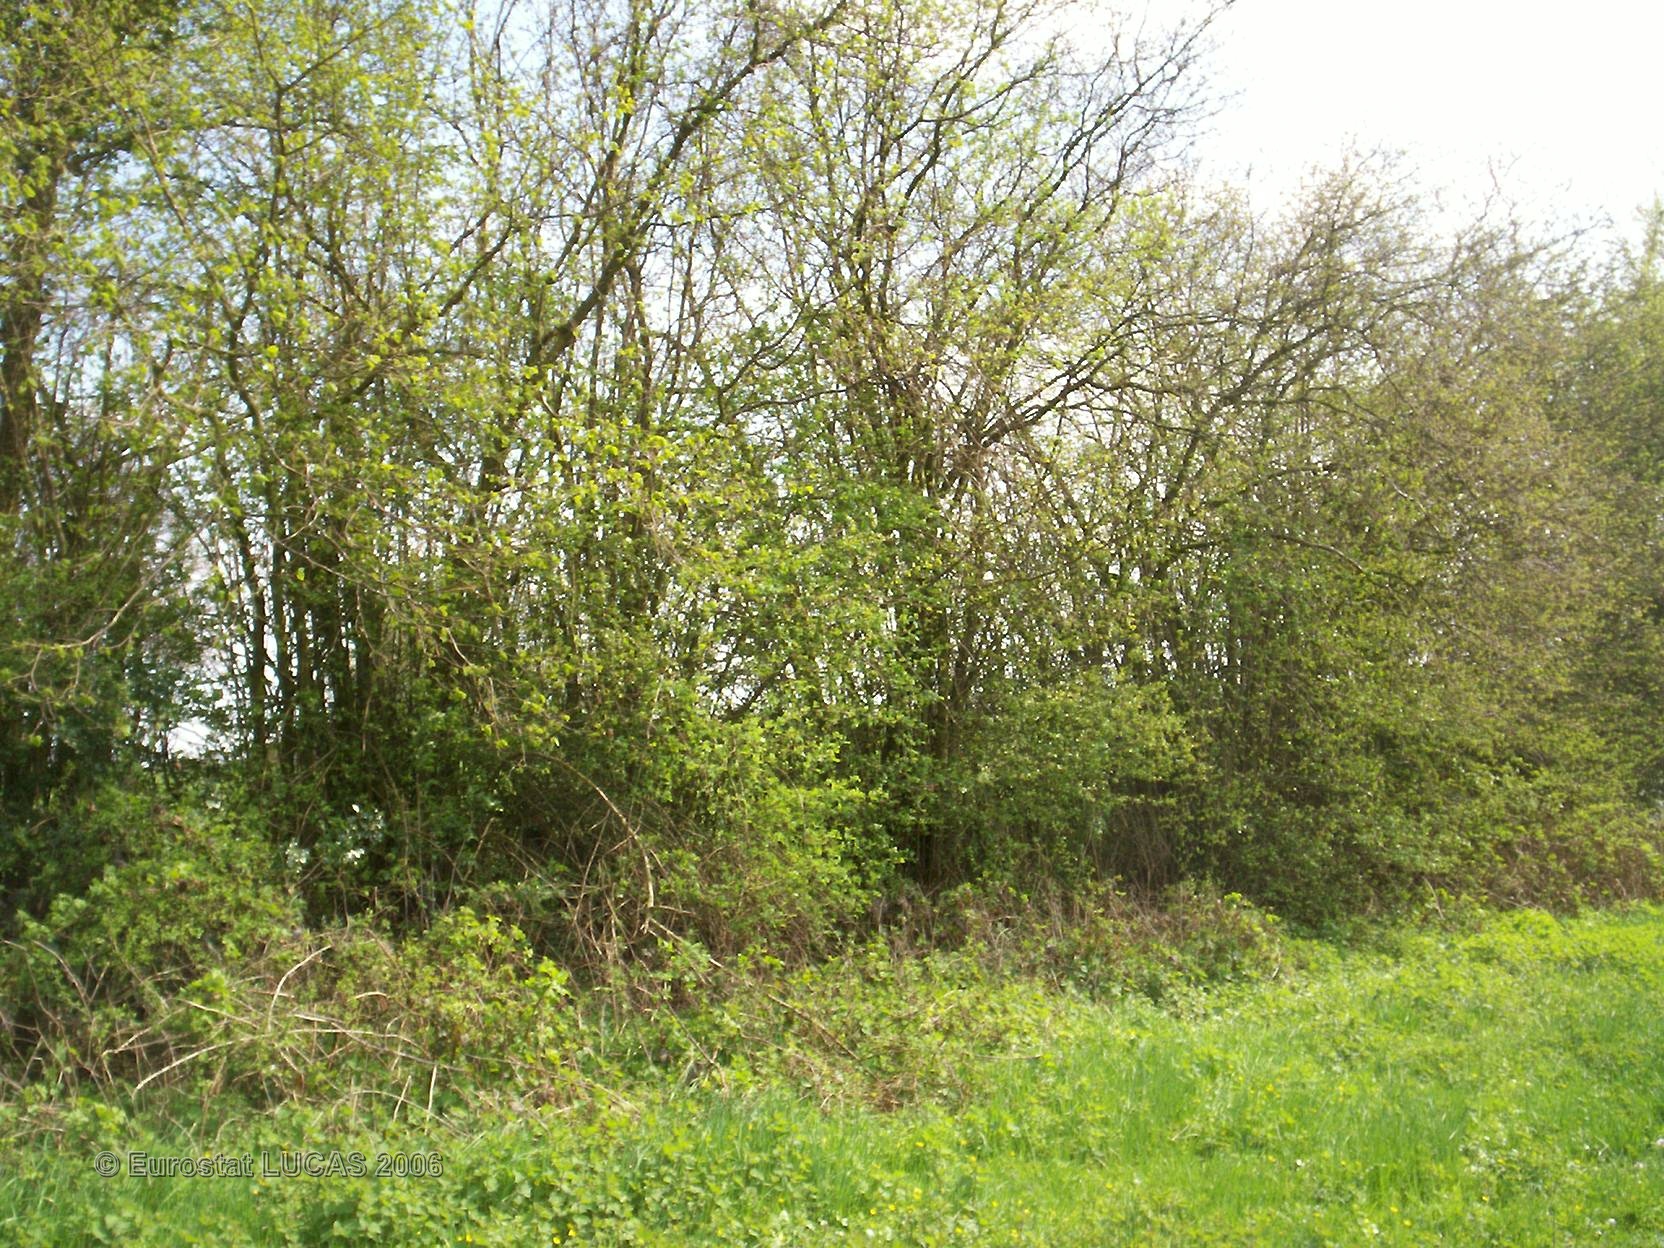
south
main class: Grassland
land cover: Grassland without tree/shrub cover
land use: Agriculture (excluding fallow land and kitchen gardens)
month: April
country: FR
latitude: 49.7721
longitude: 4.3164
